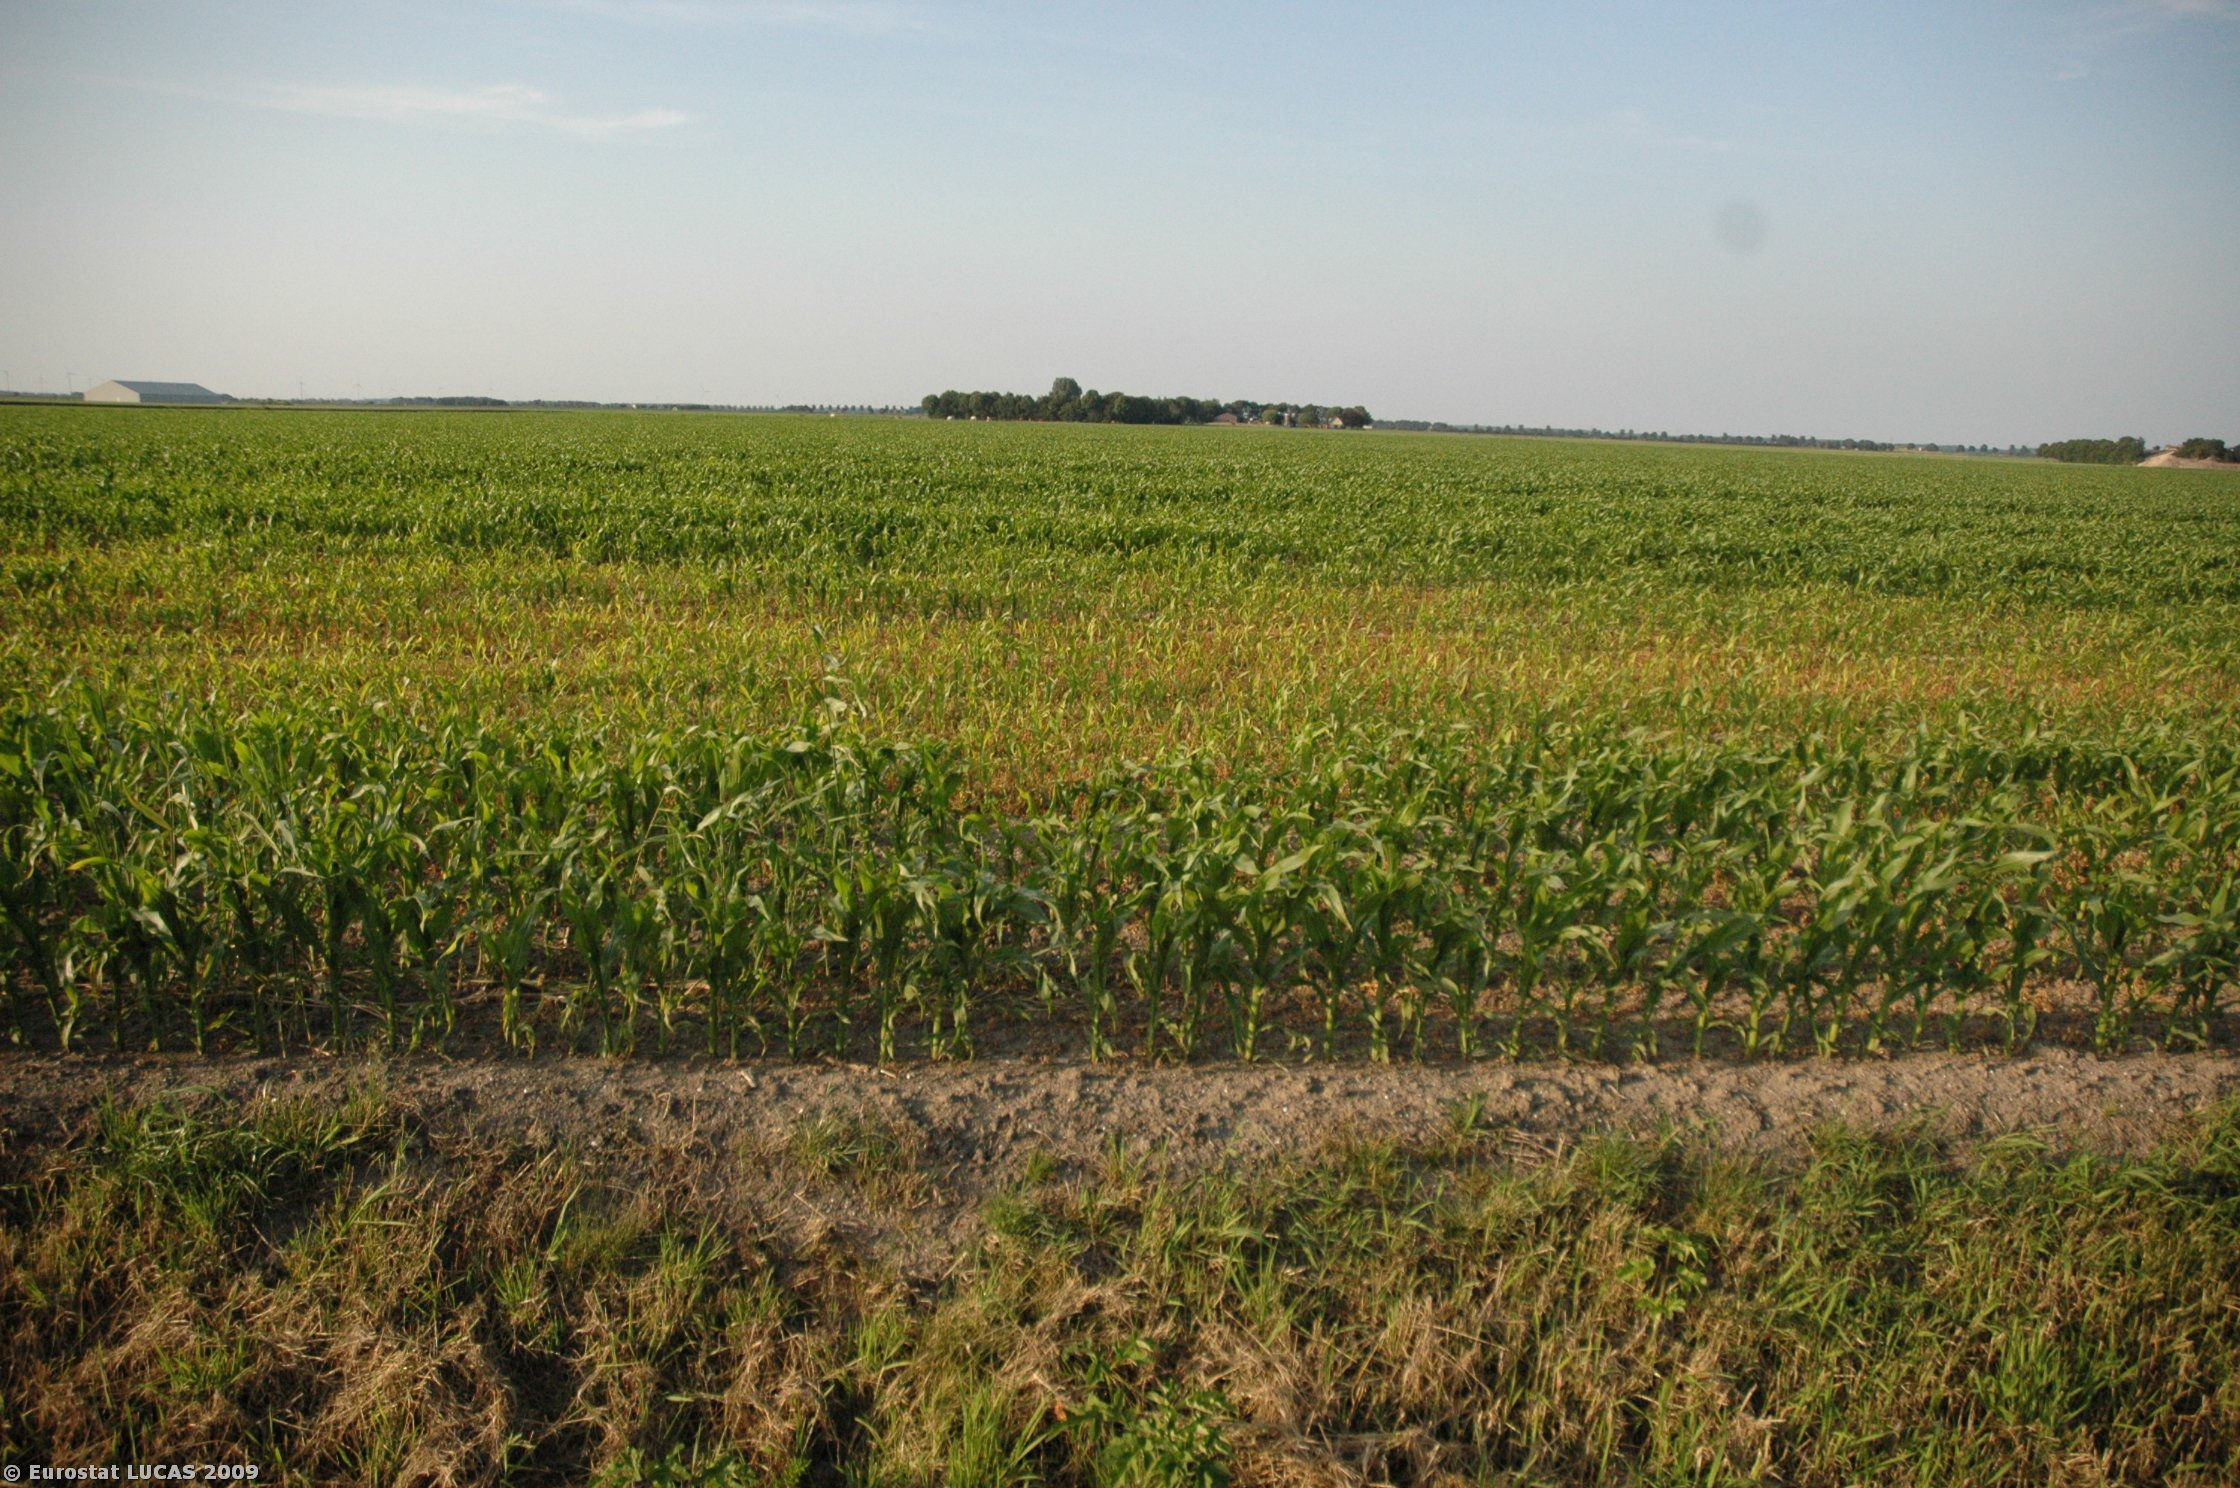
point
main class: Cropland
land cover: Maize
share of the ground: > 75 %
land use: Agriculture (excluding fallow land and kitchen gardens)
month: June
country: NL
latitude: 52.2697
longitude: 5.3821
